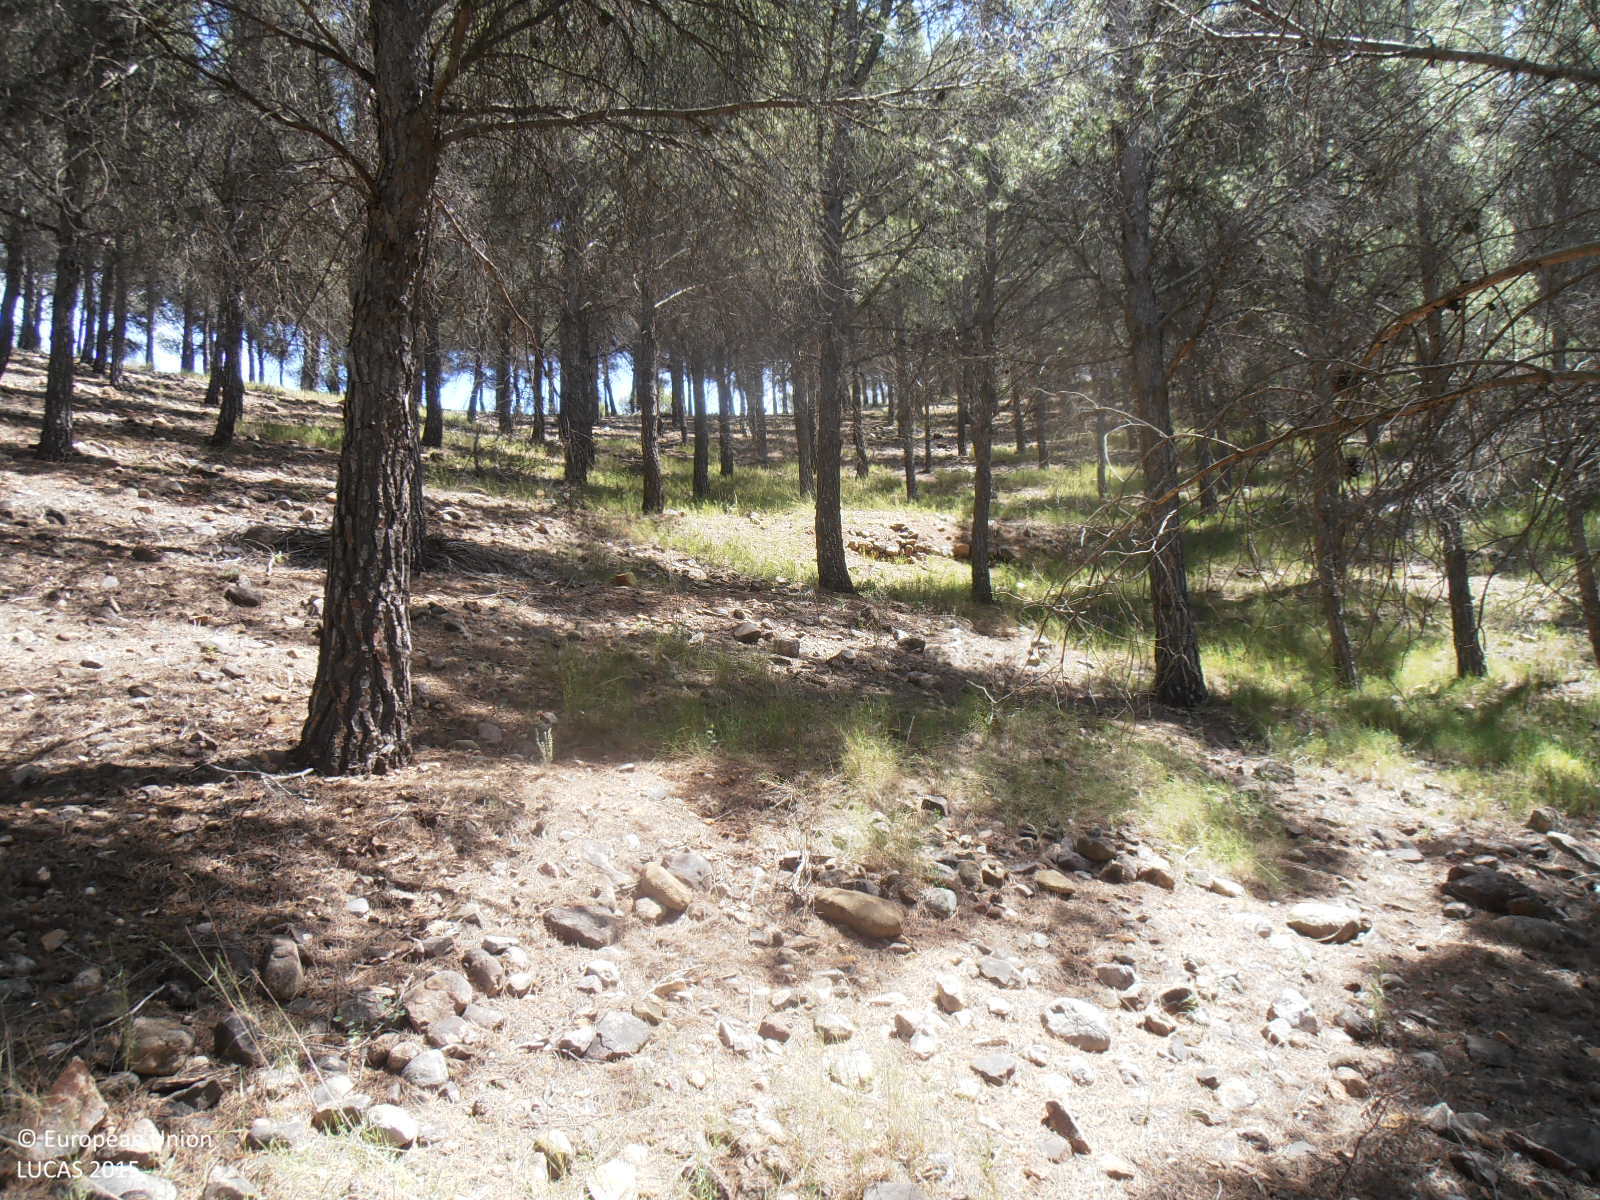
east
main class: Woodland
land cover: Pine dominated coniferous woodland
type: coniferous forest of the mediterranean region
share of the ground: > 75 %
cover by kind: coniferous forest trees 80 %, herbaceous plants 20 %
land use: Forestry
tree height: > 5 m
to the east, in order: Pine dominated coniferous woodland
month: April
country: ES
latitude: 41.2404
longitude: -0.9361
